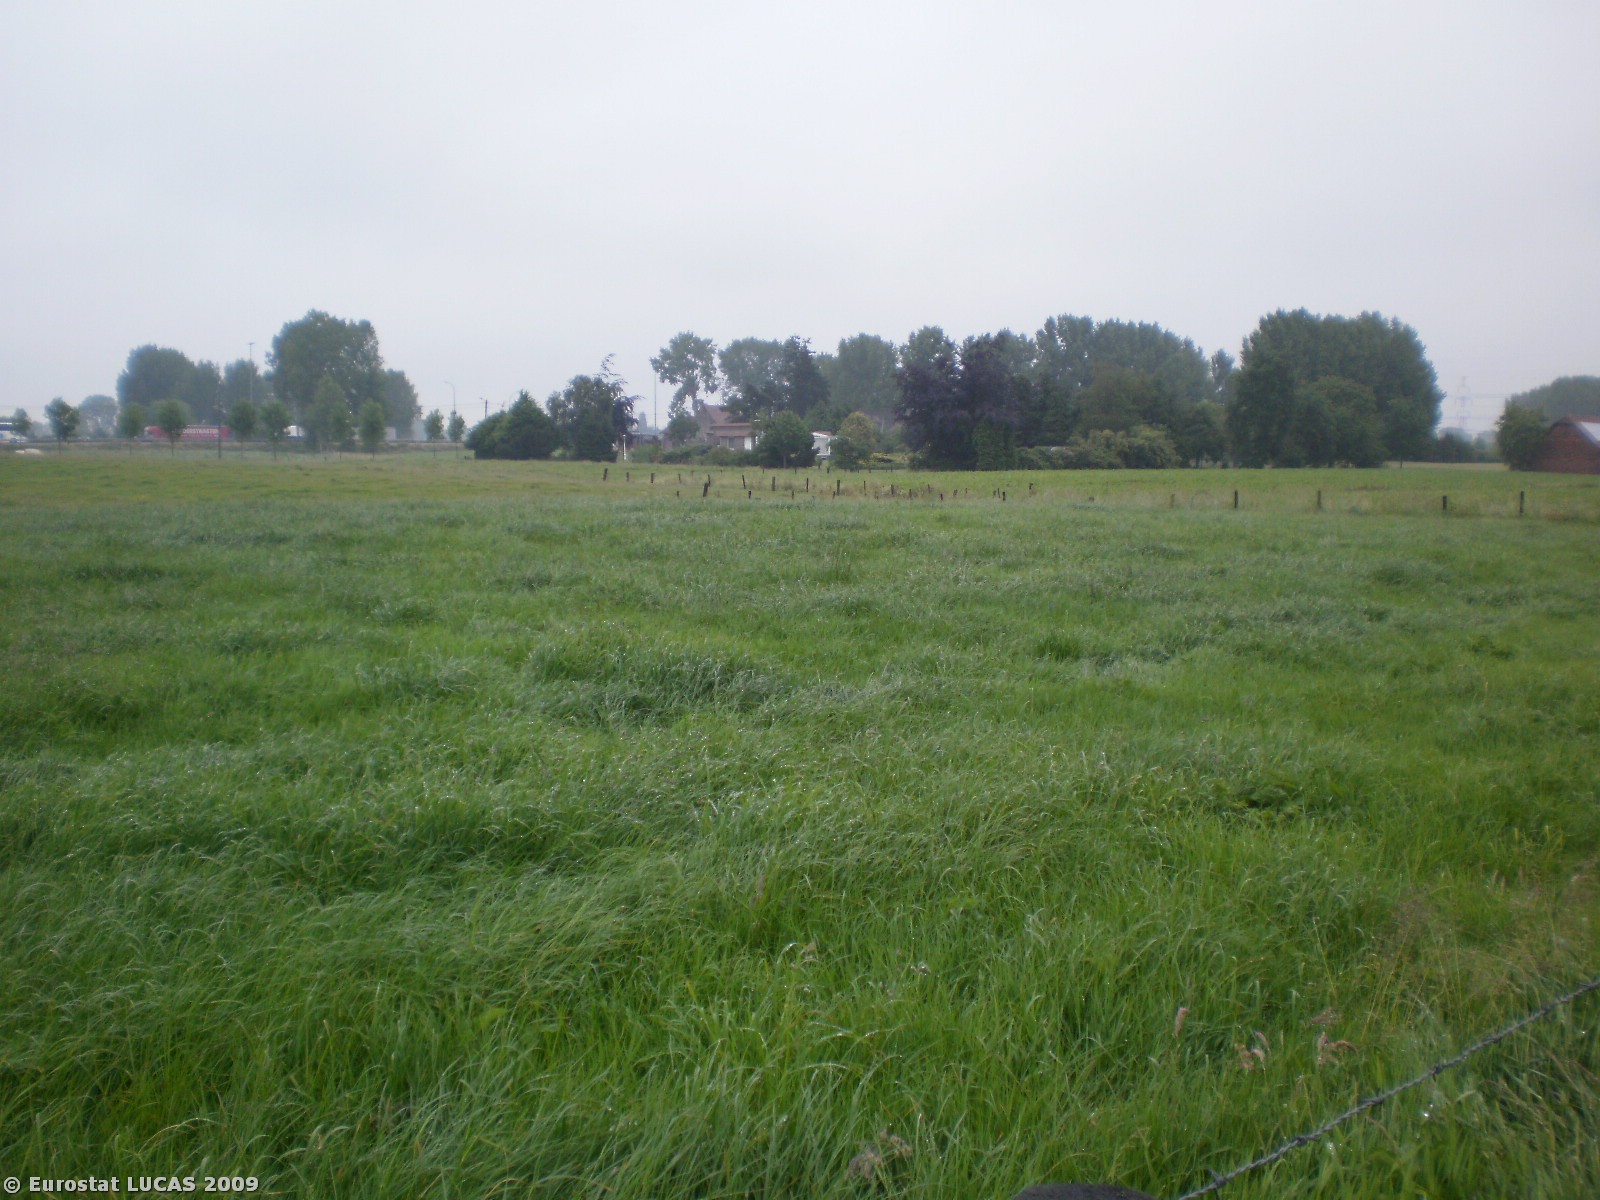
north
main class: Grassland
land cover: Grassland without tree/shrub cover
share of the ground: > 75 %
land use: Agriculture (excluding fallow land and kitchen gardens)
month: June
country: BE
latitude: 51.1559
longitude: 4.2329
